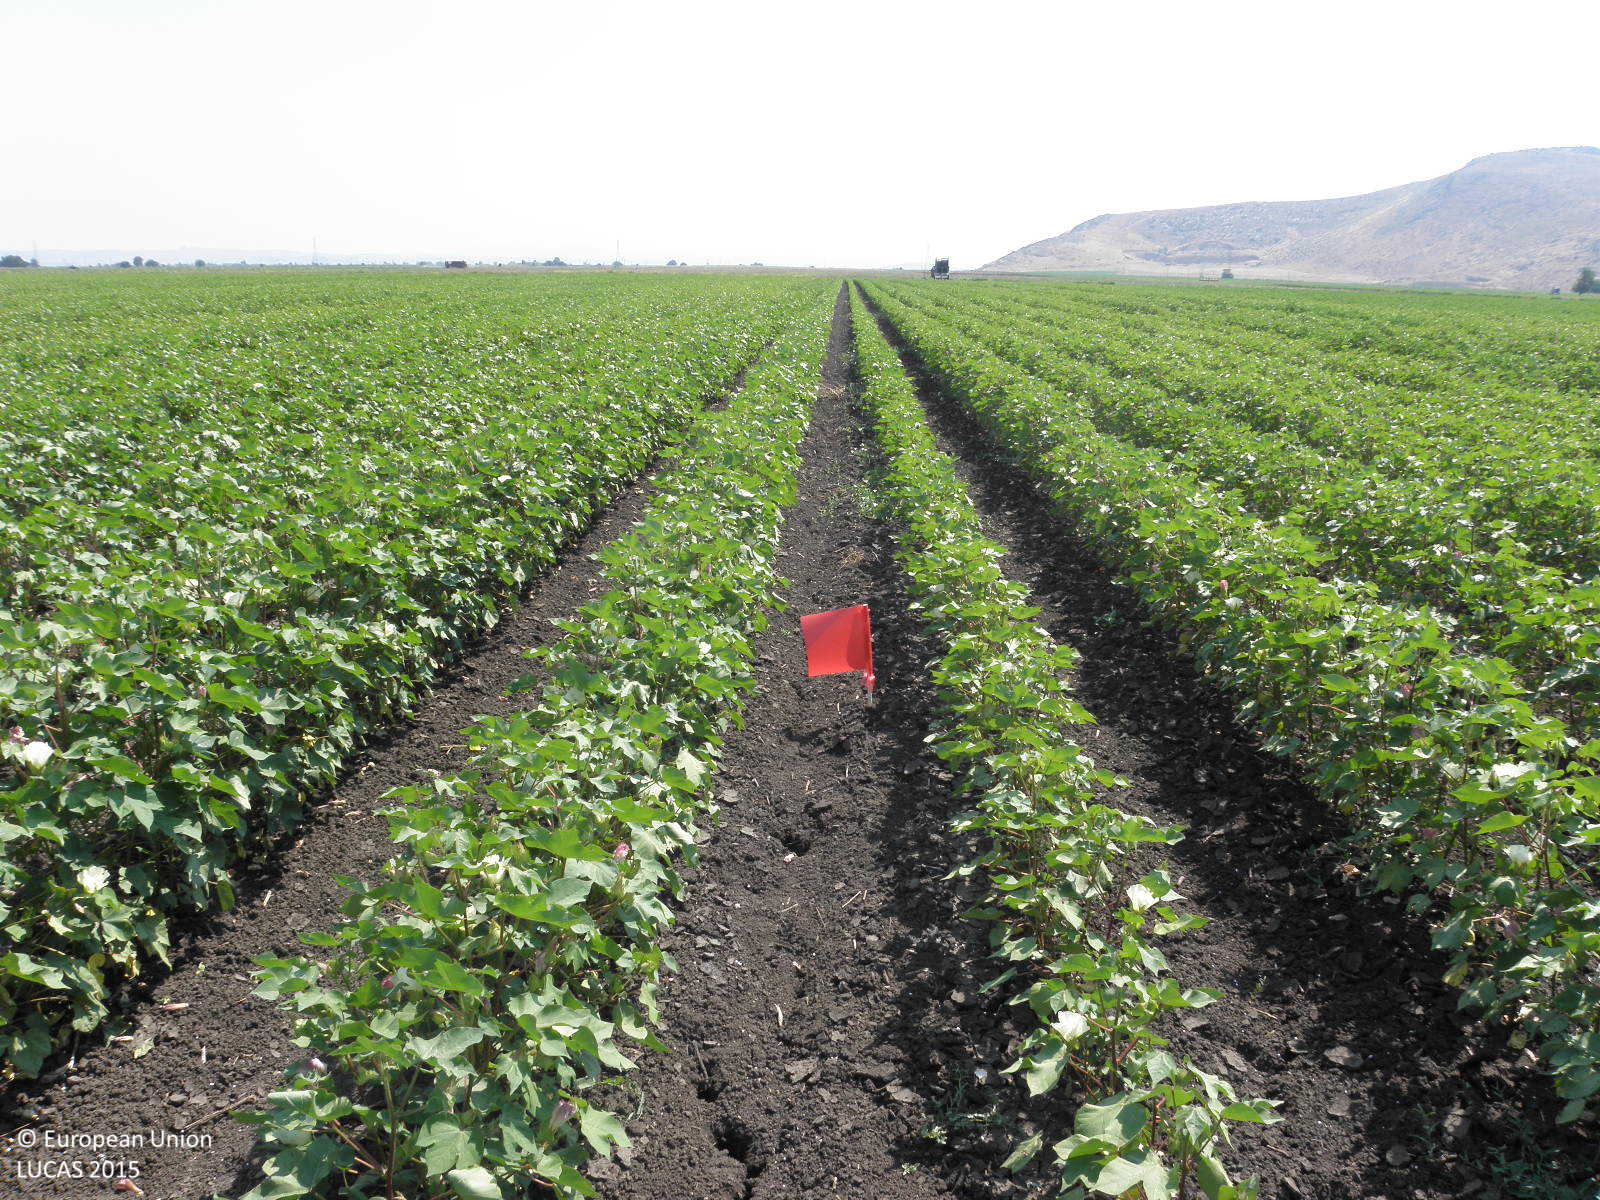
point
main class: Cropland
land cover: Cotton
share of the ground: > 75 %
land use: Agriculture (excluding fallow land and kitchen gardens)
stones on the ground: < 10 %
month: July
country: GR
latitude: 39.2909
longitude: 22.2859
